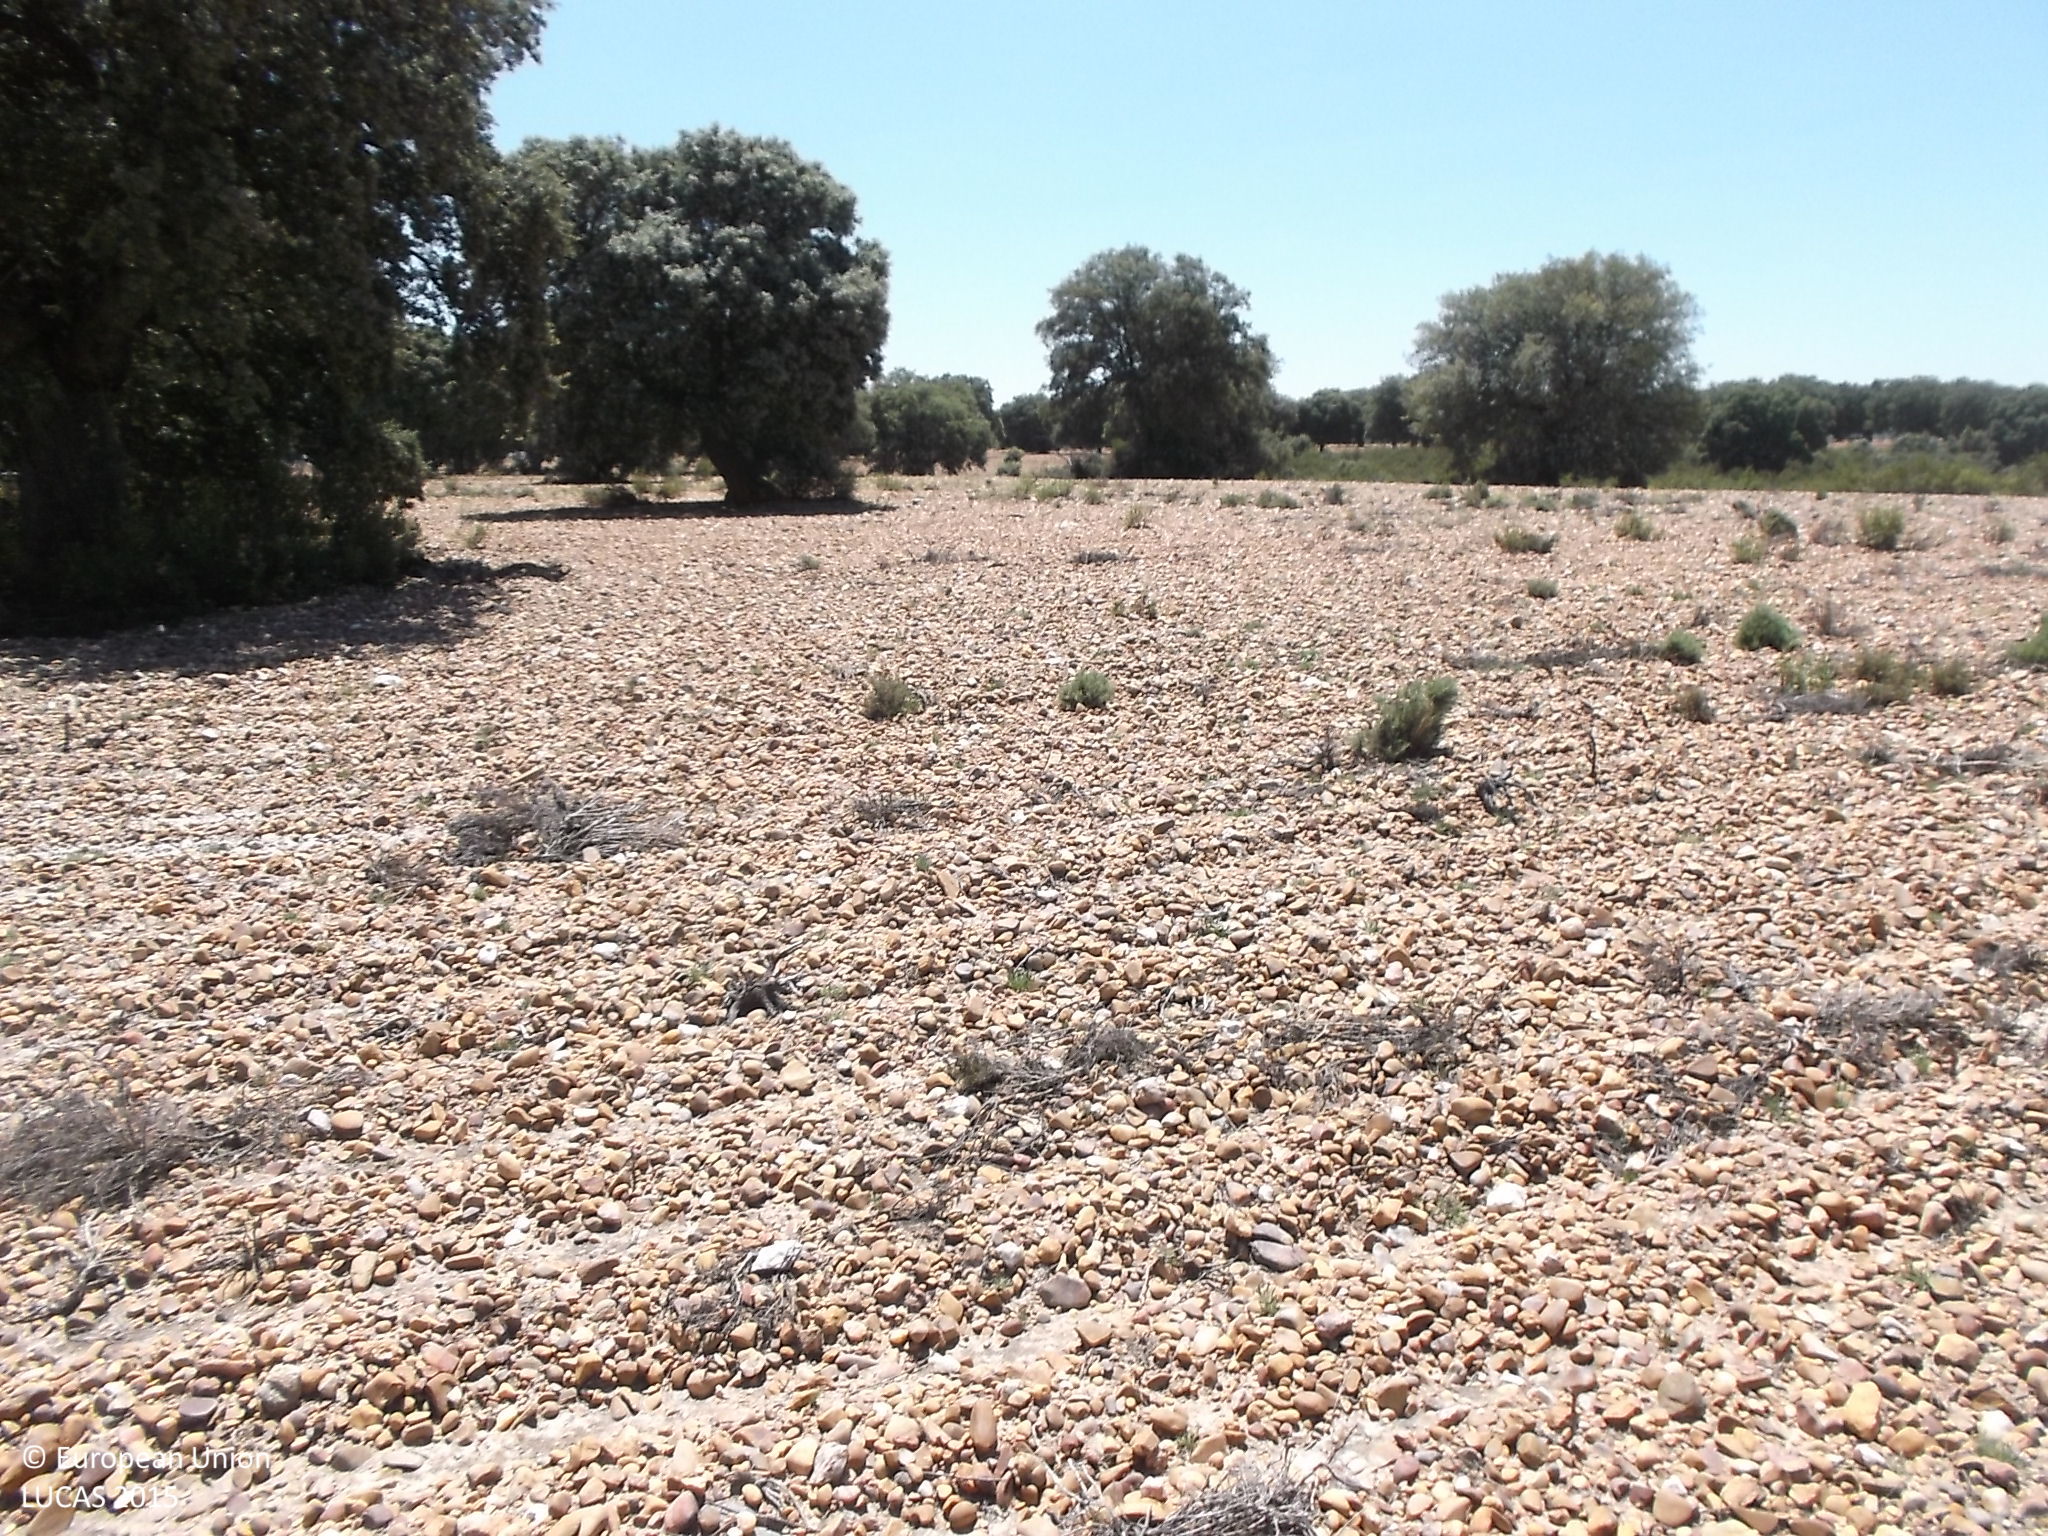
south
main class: Woodland
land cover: Broadleaved woodland
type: broadleaved evergreen forest
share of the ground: 10 - 25 %
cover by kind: unconsolidated bare surface 80 %, broadleaved forest trees 20 %
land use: Forestry
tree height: < 5 m
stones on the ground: 10 - 25 %
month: July
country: ES
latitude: 41.5042
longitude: -5.8670
